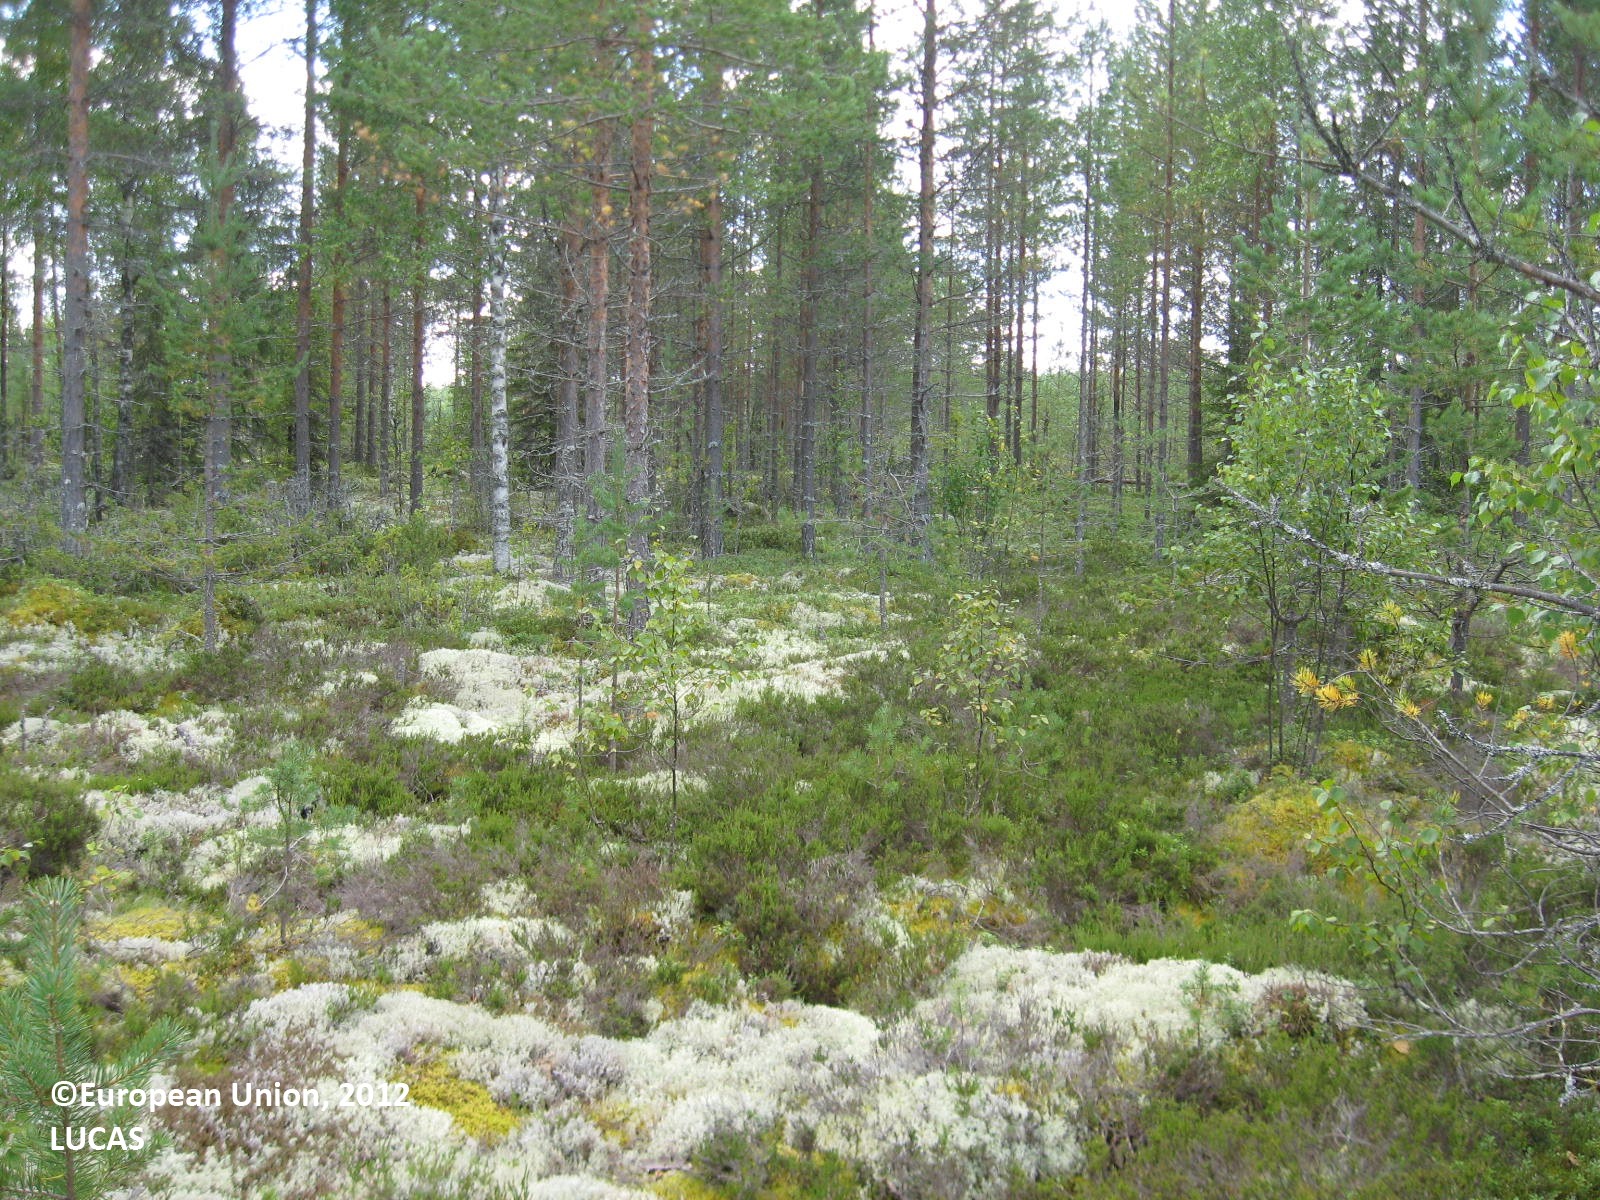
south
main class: Woodland
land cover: Pine dominated coniferous woodland
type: boreal forest
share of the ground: 50 - 75 %
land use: Forestry
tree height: > 5 m
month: August
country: FI
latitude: 63.4782
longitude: 30.2722
